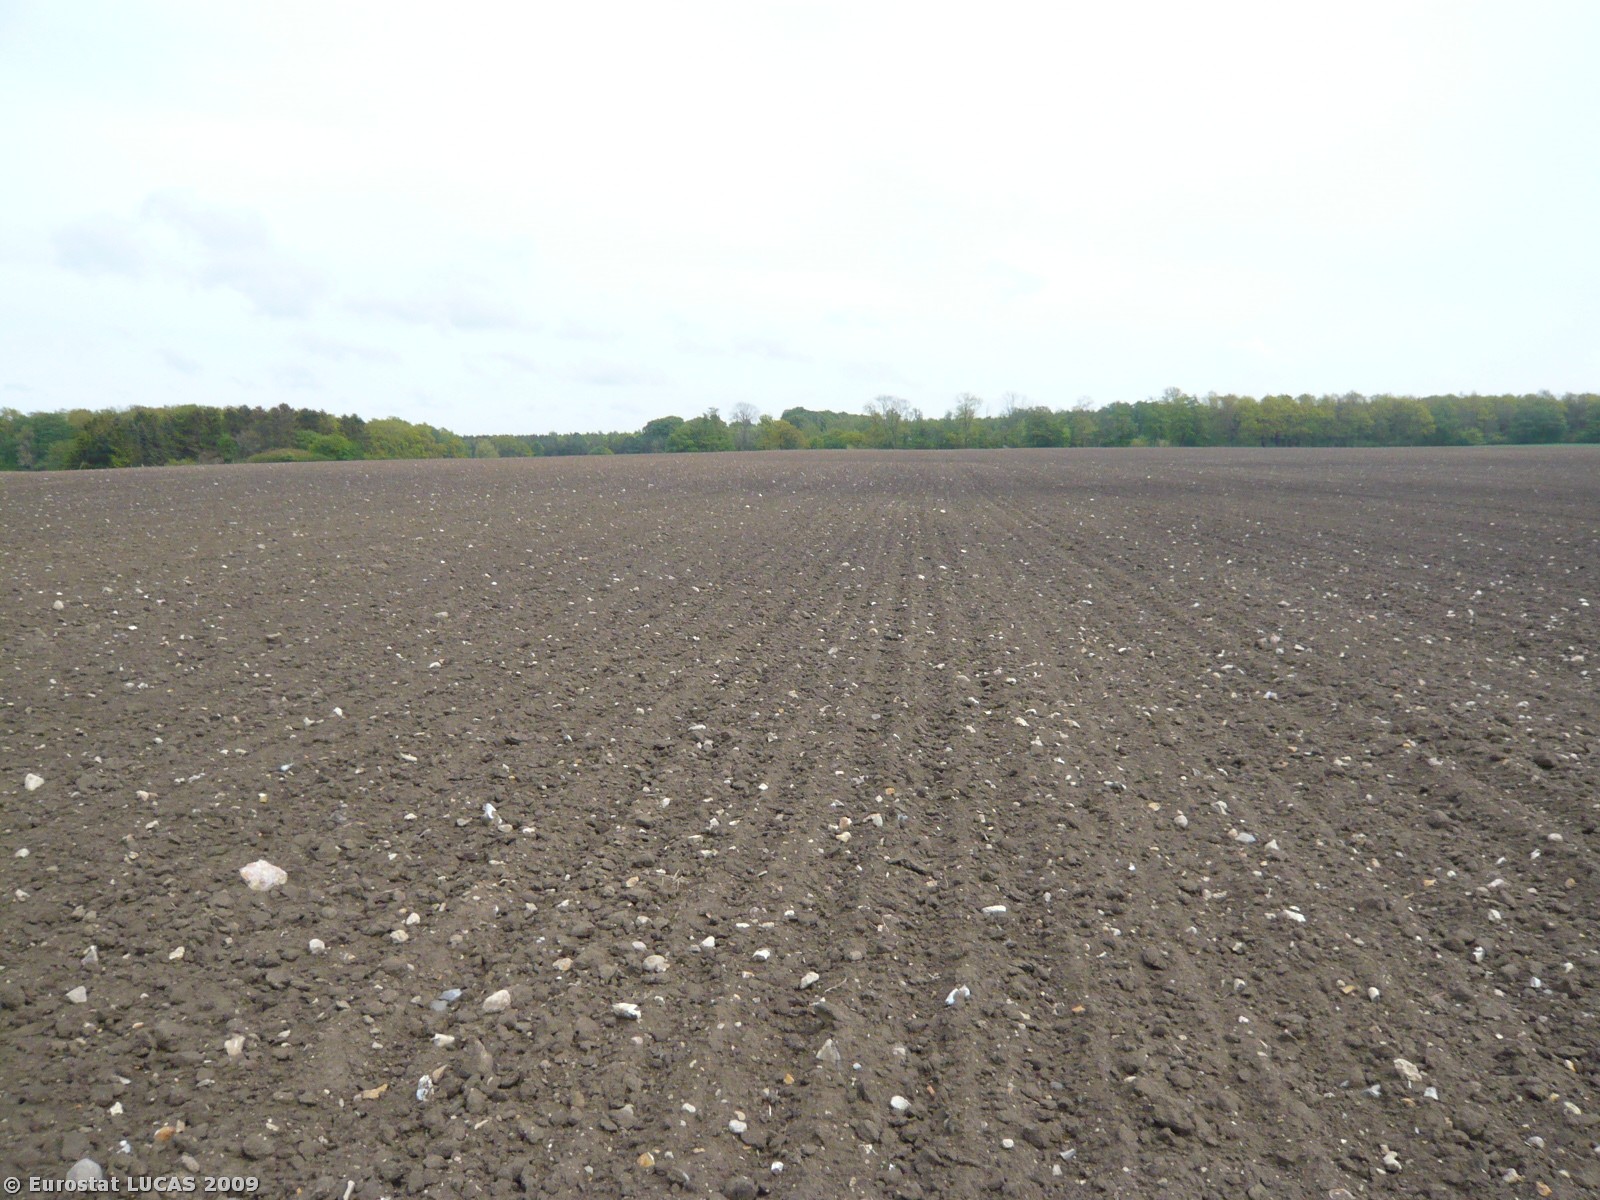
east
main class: Cropland
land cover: Other root crops
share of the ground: < 10 %
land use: Agriculture (excluding fallow land and kitchen gardens)
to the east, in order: Other root crops
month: May
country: DK
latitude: 55.2722
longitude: 12.0604
